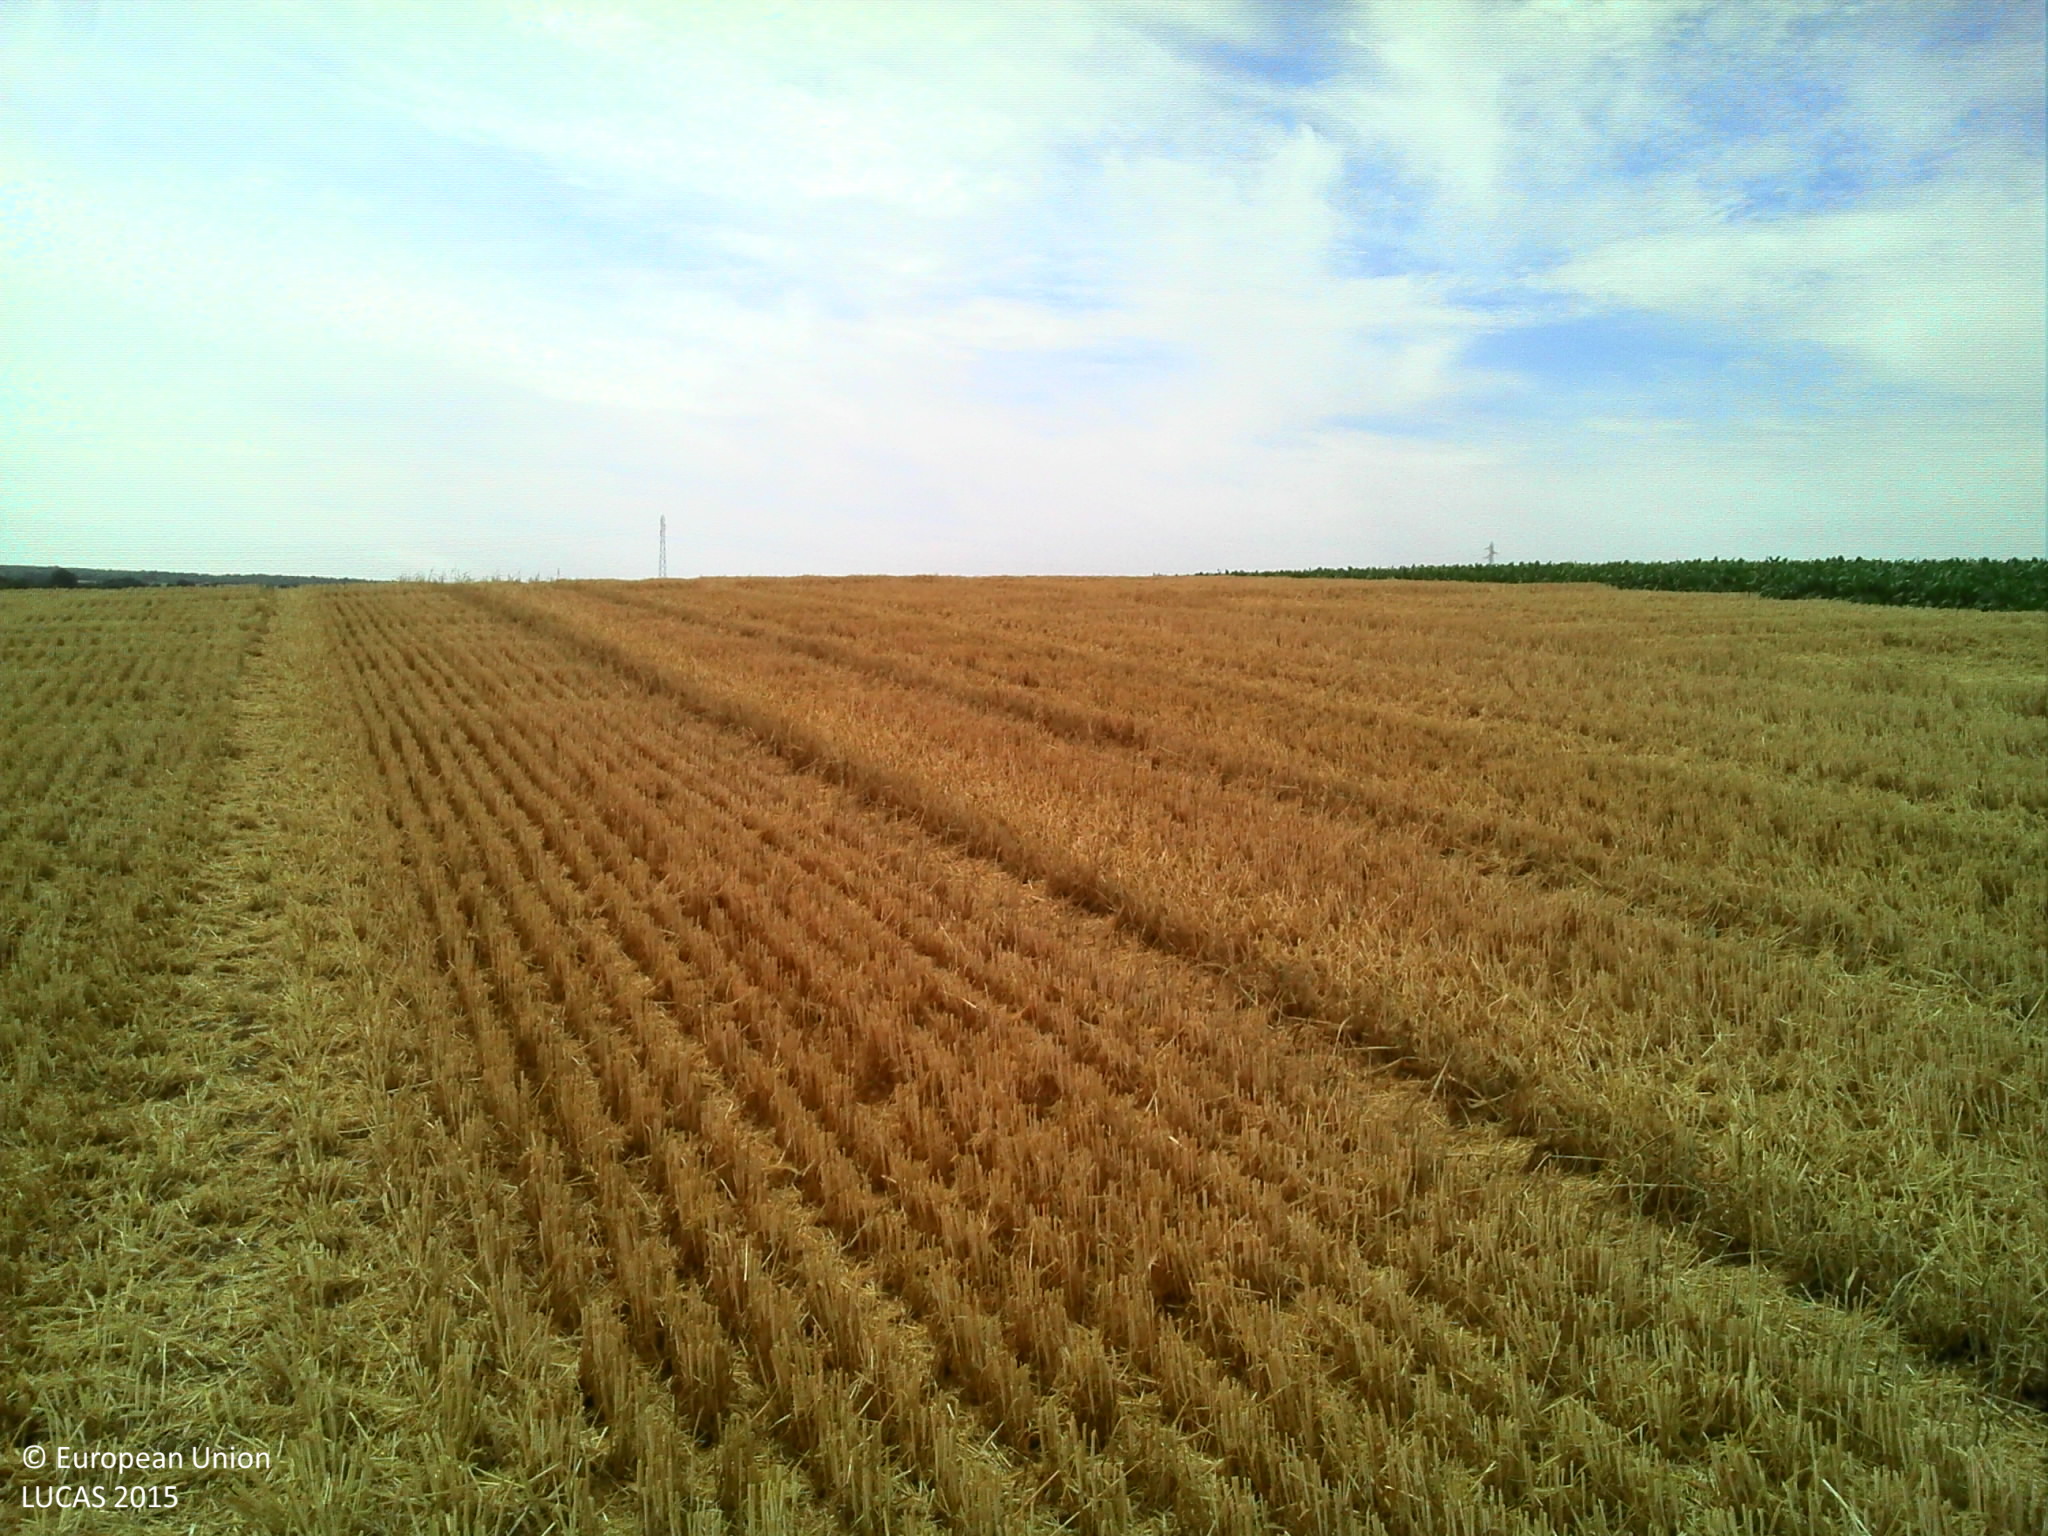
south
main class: Cropland
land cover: Barley
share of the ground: > 75 %
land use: Agriculture (excluding fallow land and kitchen gardens)
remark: Harvested field
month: July
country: FR
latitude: 49.2604
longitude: 4.5414
